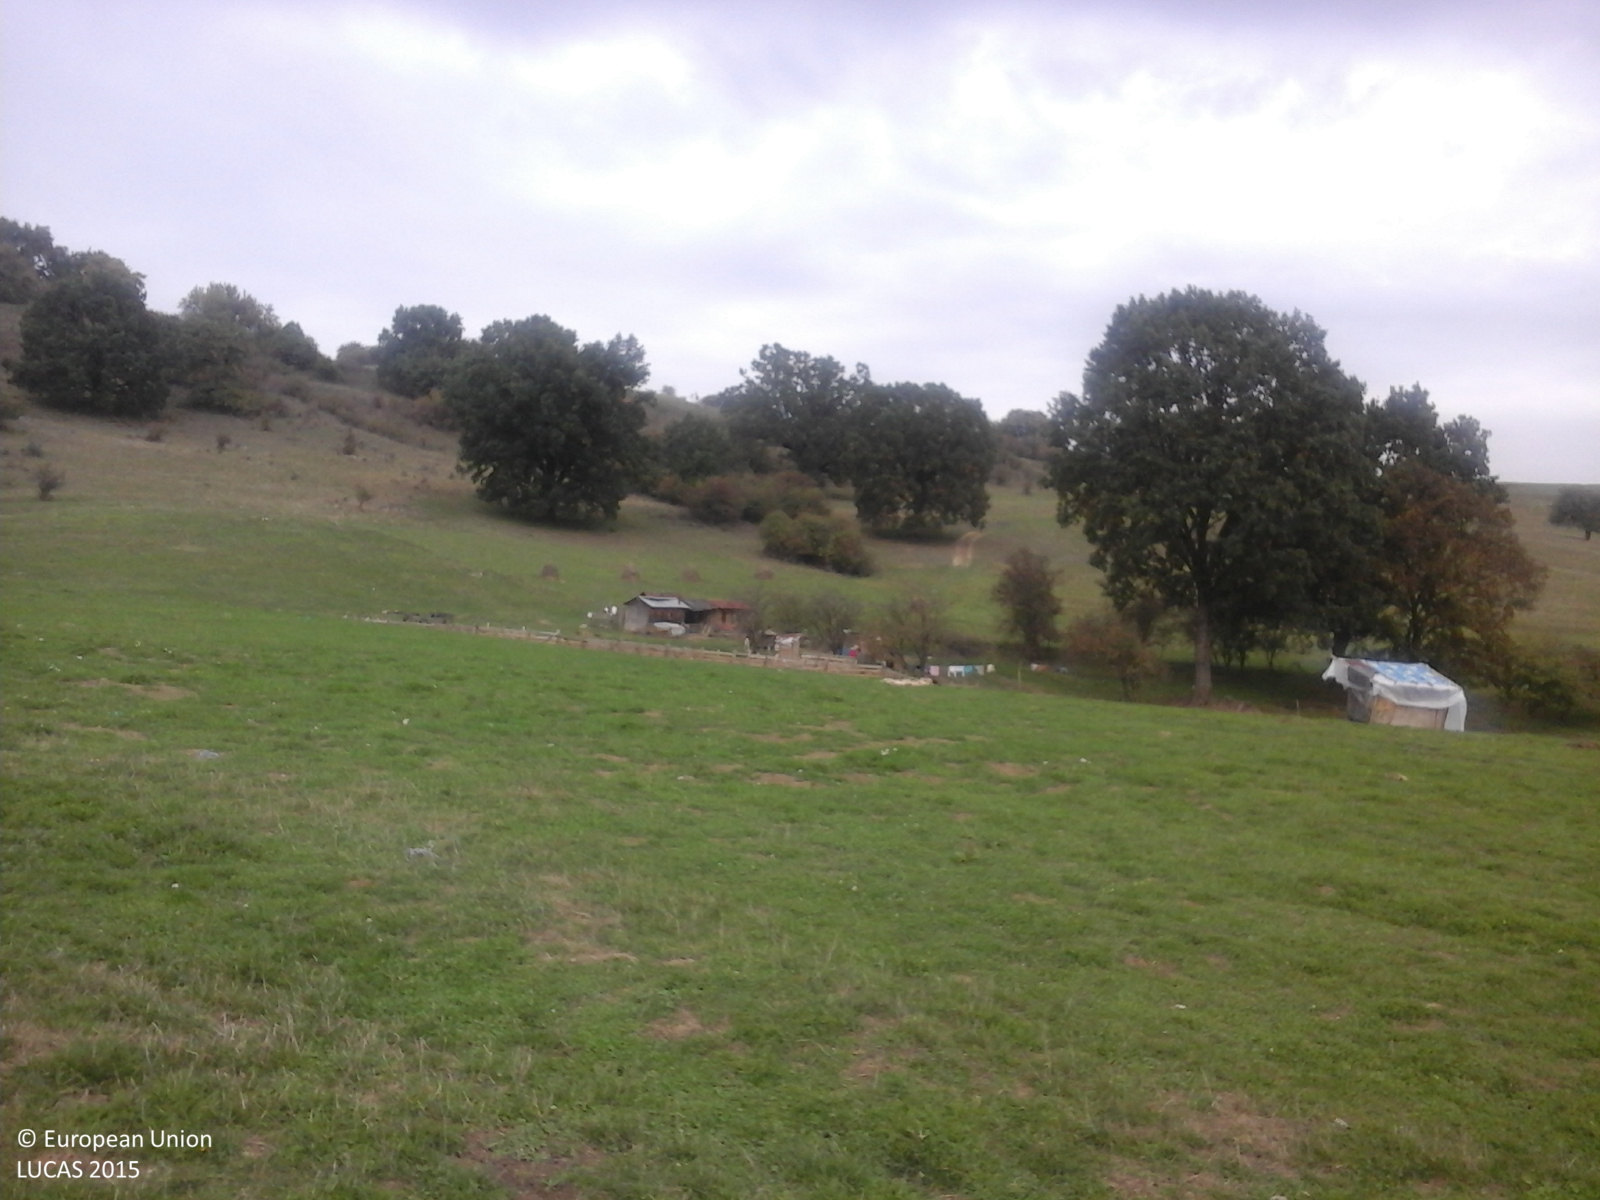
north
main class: Grassland
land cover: Grassland without tree/shrub cover
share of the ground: > 75 %
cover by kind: herbaceous plants 100 %
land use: Agriculture (excluding fallow land and kitchen gardens)
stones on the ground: < 10 %
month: October
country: RO
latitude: 46.5525
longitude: 24.8458
